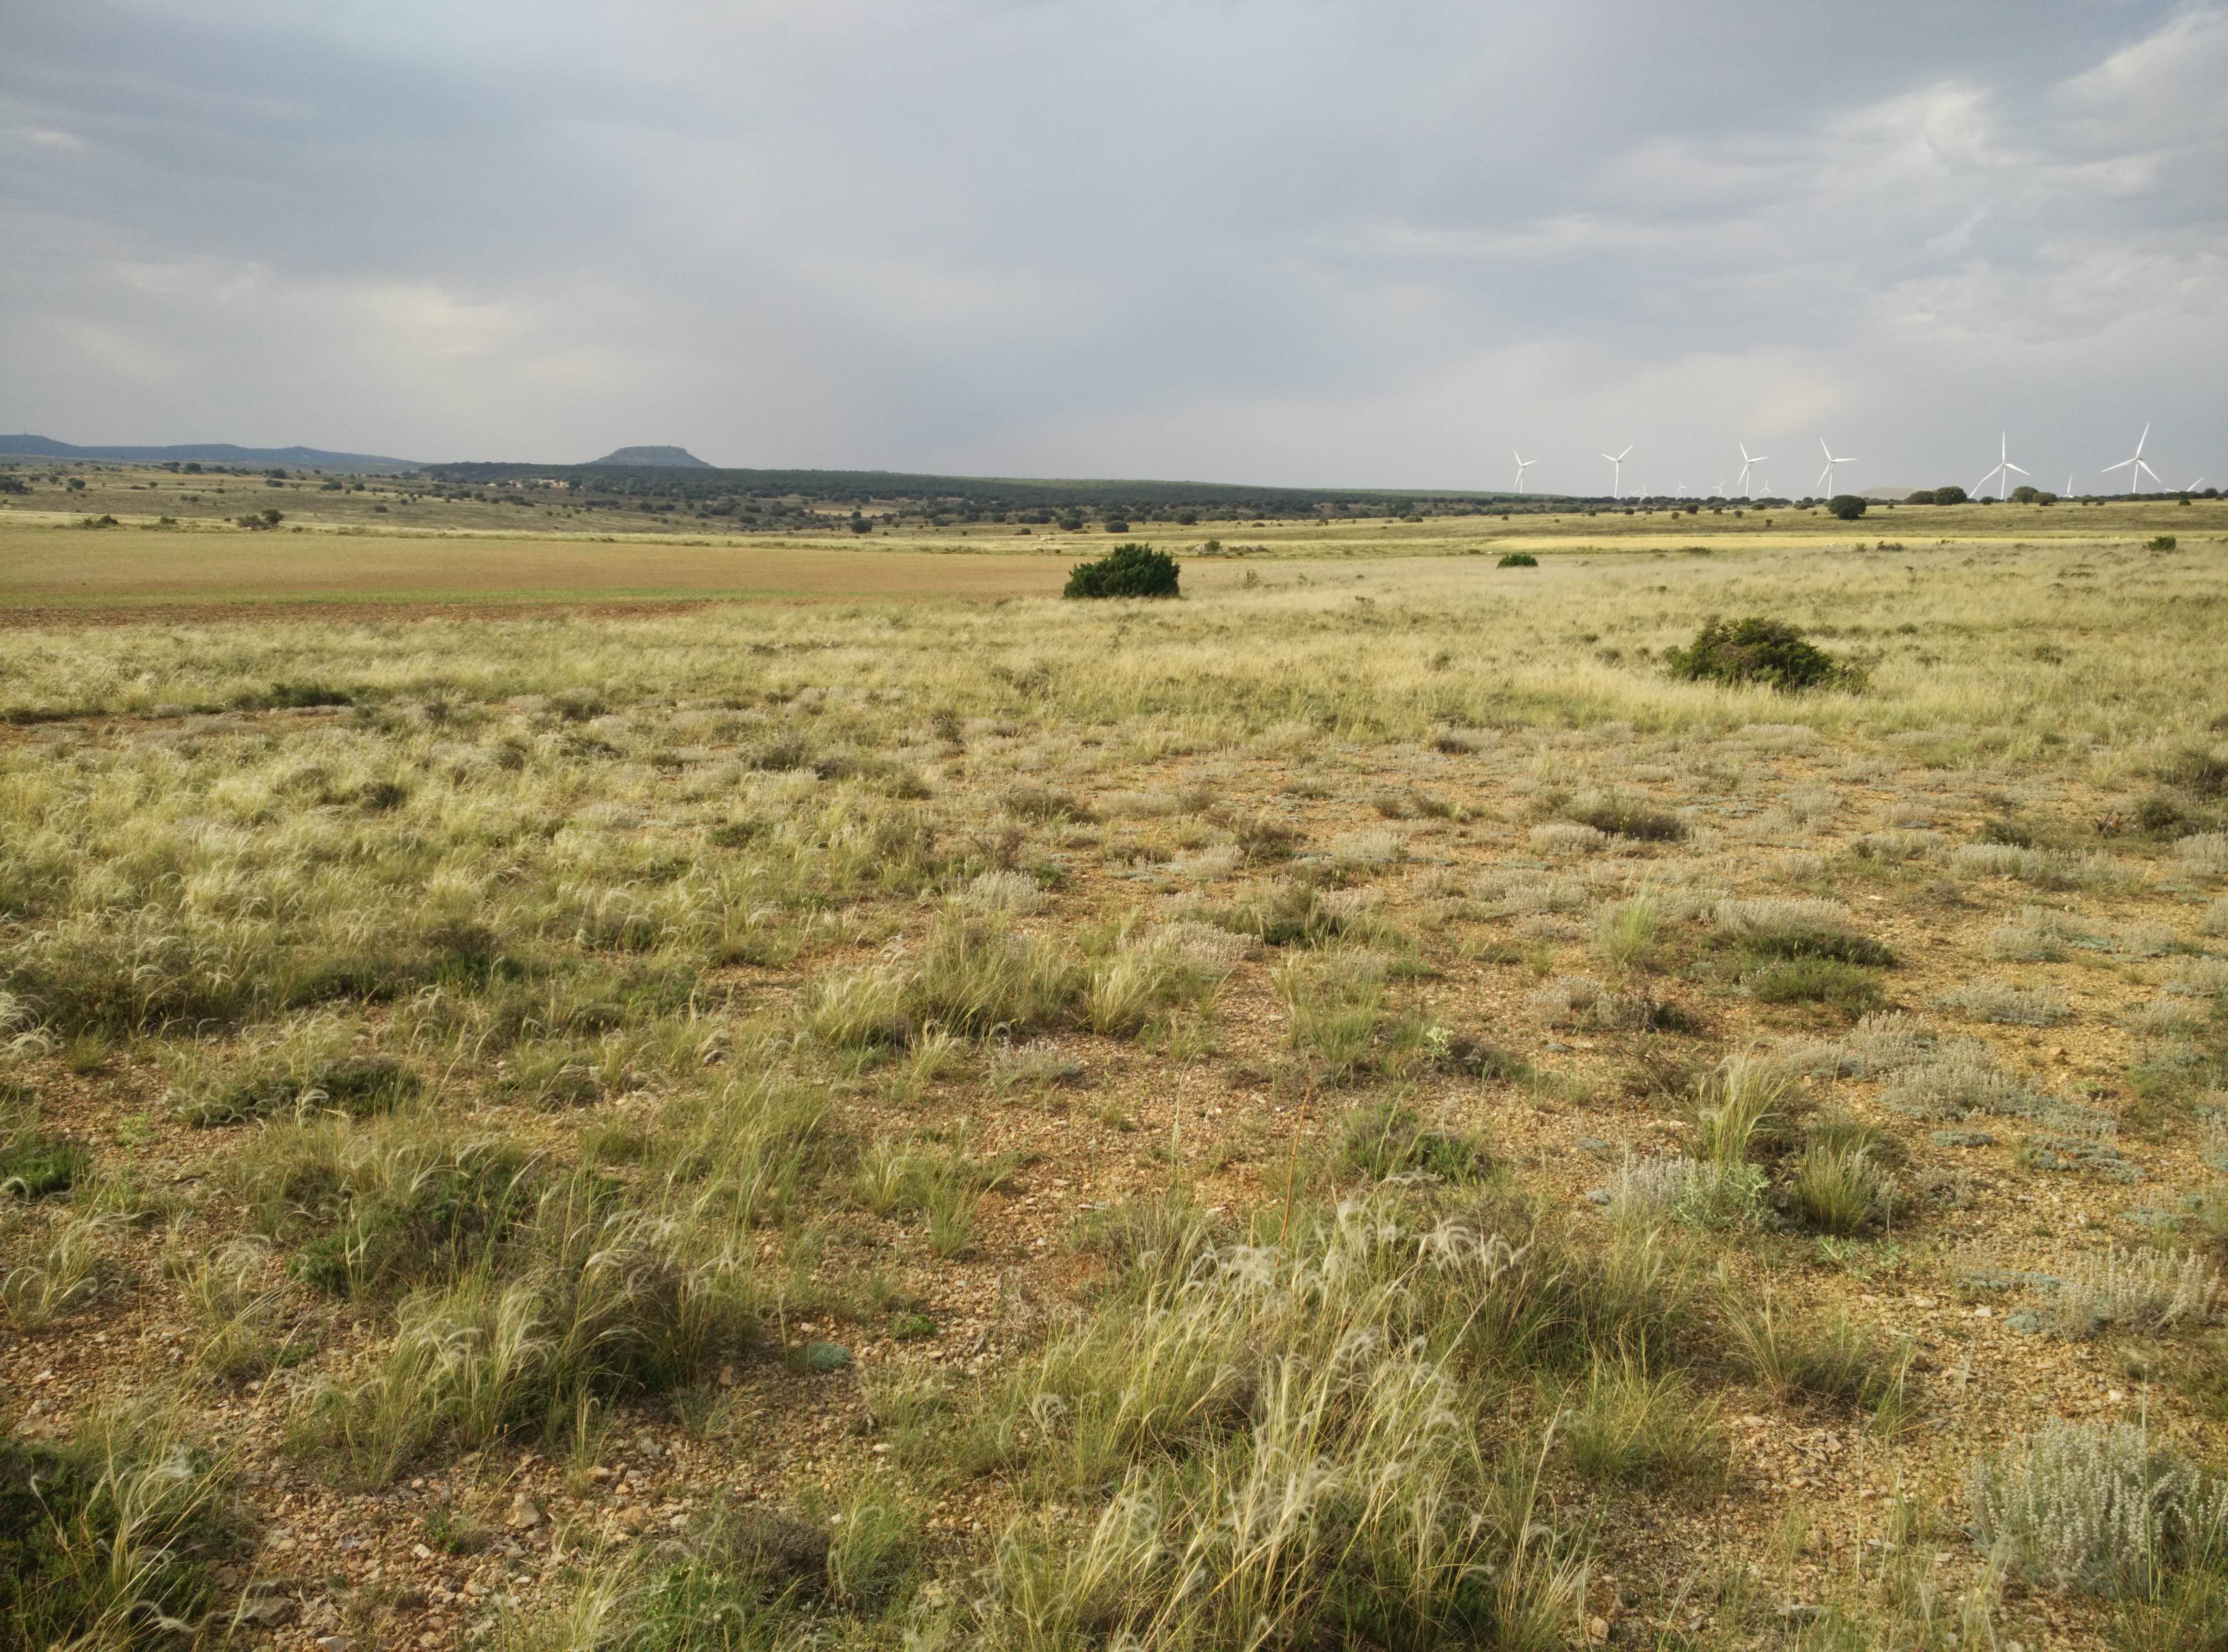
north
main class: Shrubland
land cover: Shrubland without tree cover
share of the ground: 50 - 75 %
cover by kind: shrubs 50 %, unconsolidated bare surface 45 %, herbaceous plants 5 %
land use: Agriculture (excluding fallow land and kitchen gardens)
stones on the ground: 25 - 50 %
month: July
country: ES
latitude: 40.9861
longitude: -1.8739
